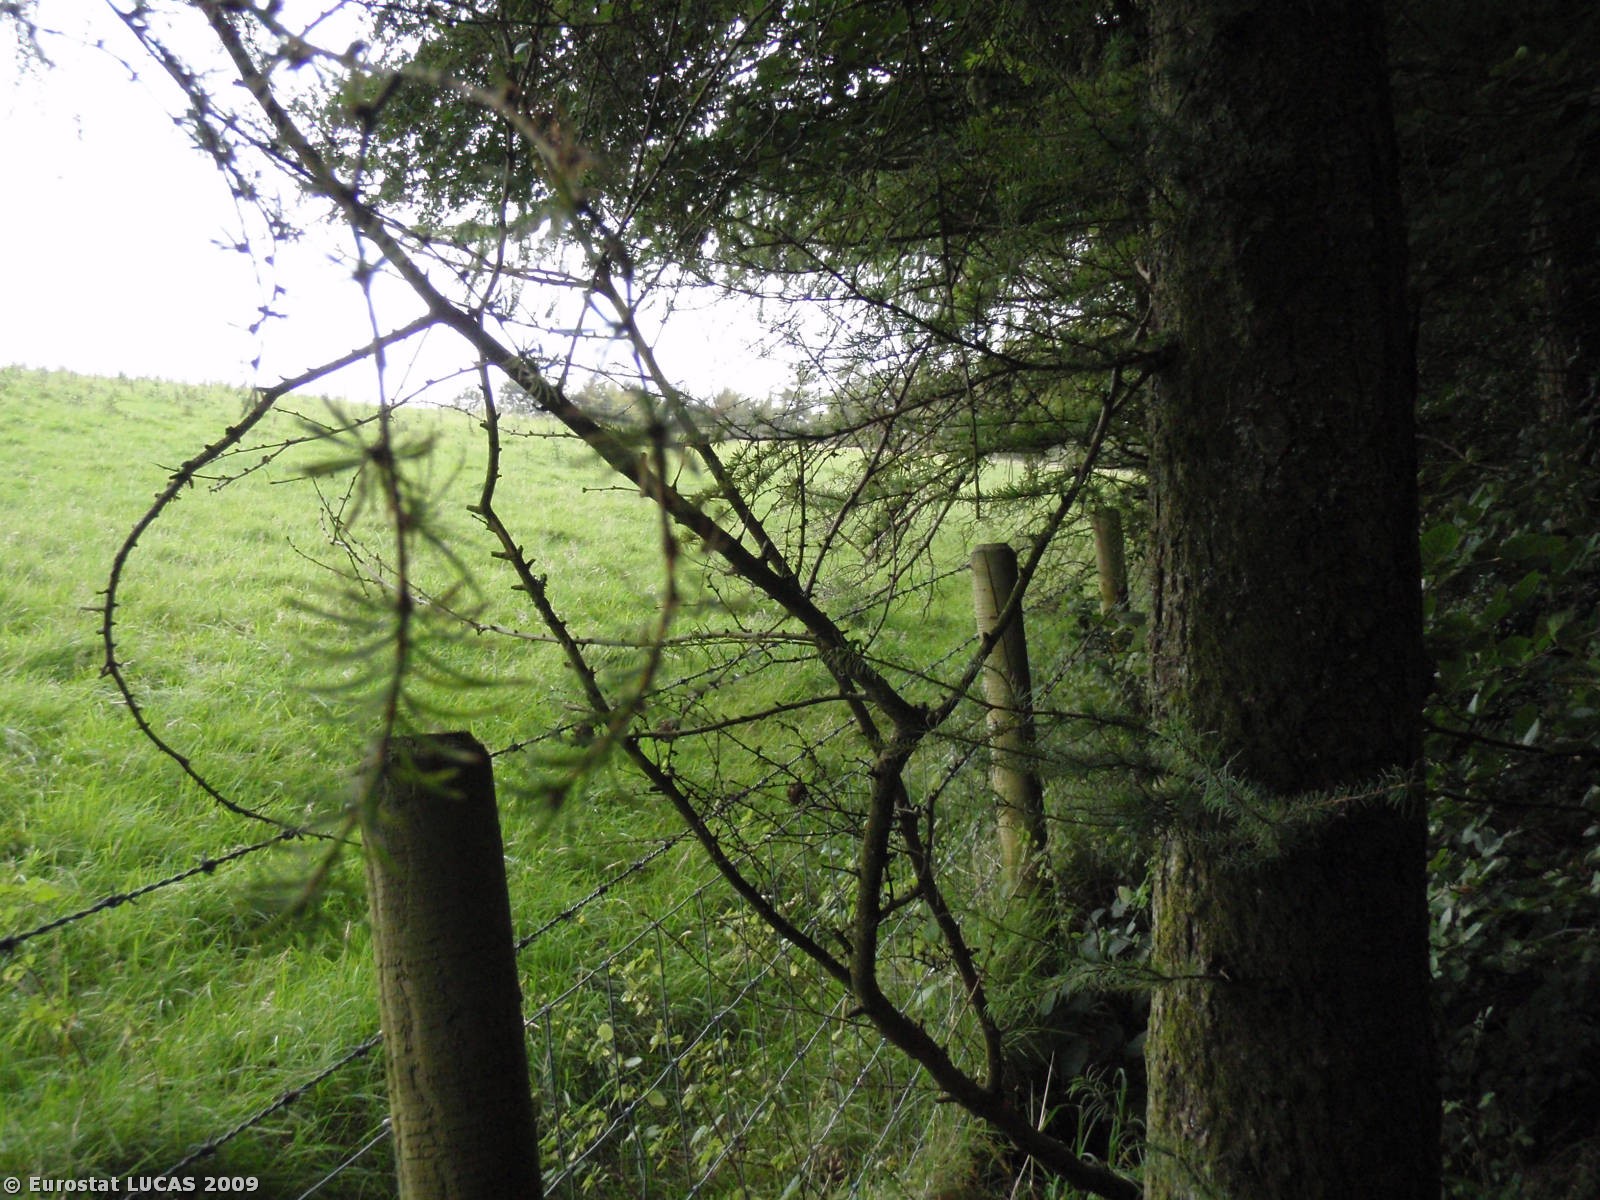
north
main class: Grassland
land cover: Grassland without tree/shrub cover
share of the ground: > 75 %
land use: Agriculture (excluding fallow land and kitchen gardens)
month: September
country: GB
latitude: 51.0744
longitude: -3.4859
